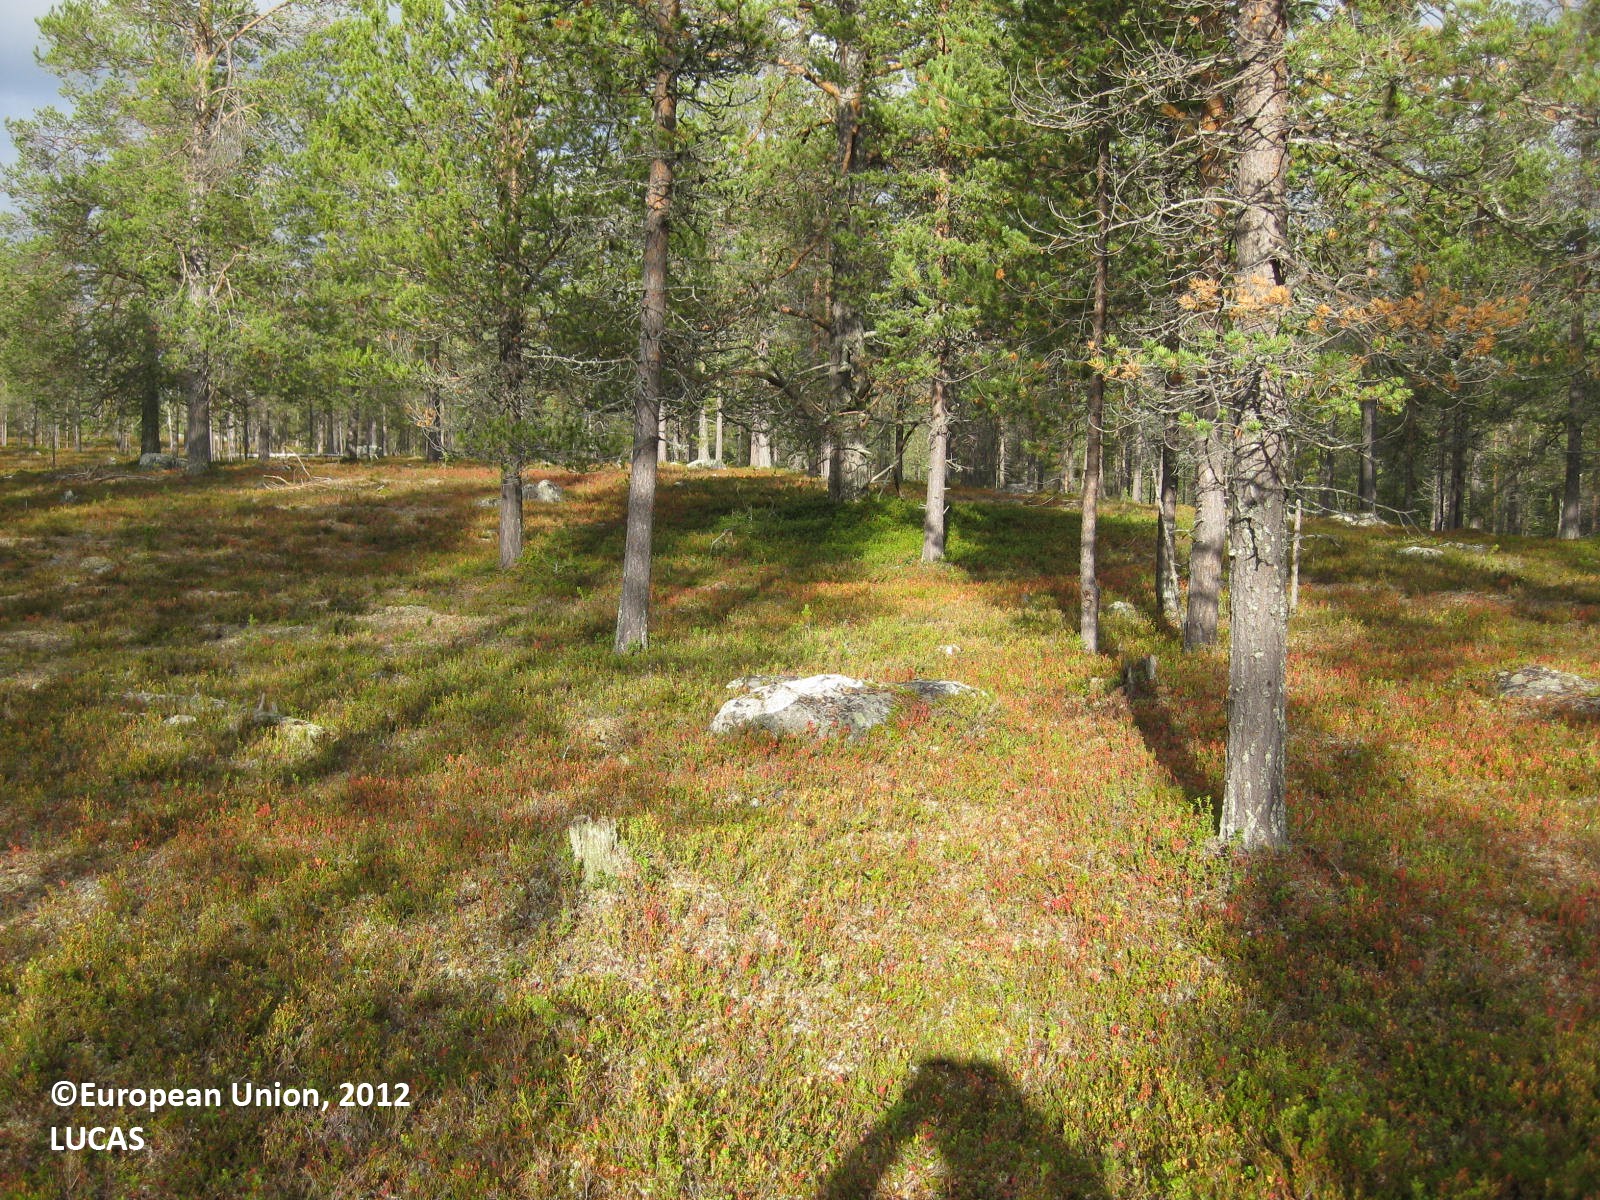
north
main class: Woodland
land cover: Pine dominated coniferous woodland
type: boreal forest
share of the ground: > 75 %
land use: Forestry
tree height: > 5 m
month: September
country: FI
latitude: 68.0120
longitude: 23.5801
